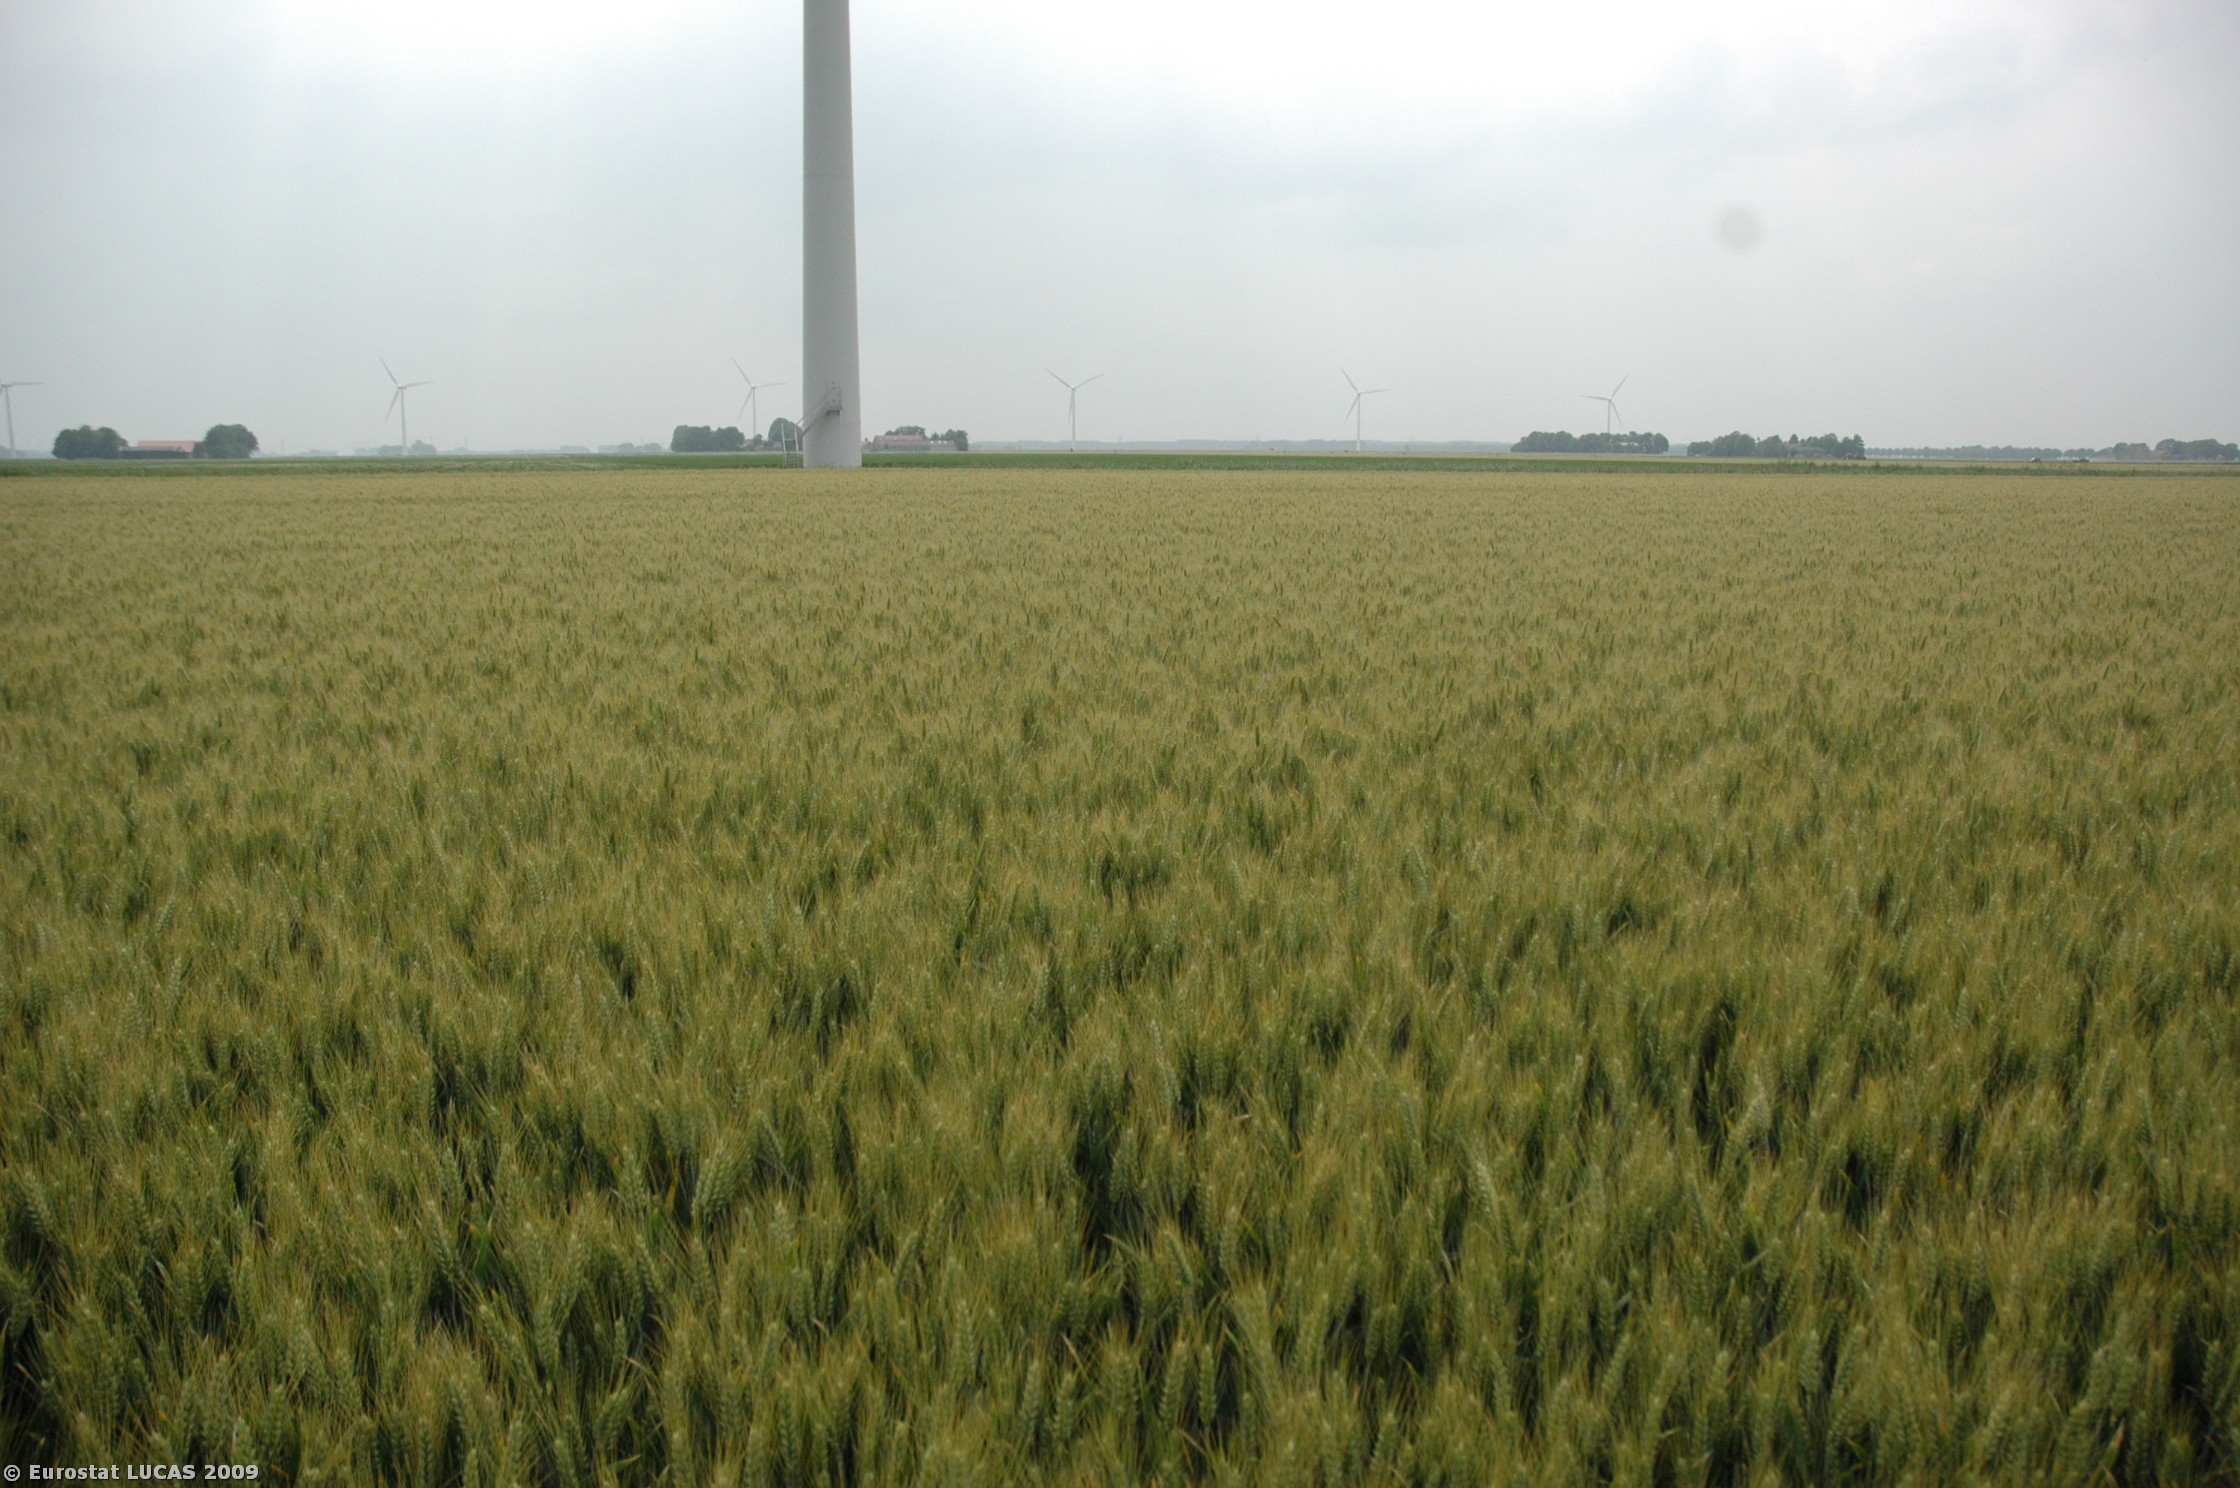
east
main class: Cropland
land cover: Common wheat
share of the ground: > 75 %
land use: Agriculture (excluding fallow land and kitchen gardens)
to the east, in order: Common wheat; Ditches and canals; Rape and turnip rape
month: June
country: NL
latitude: 52.4601
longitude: 5.6570
